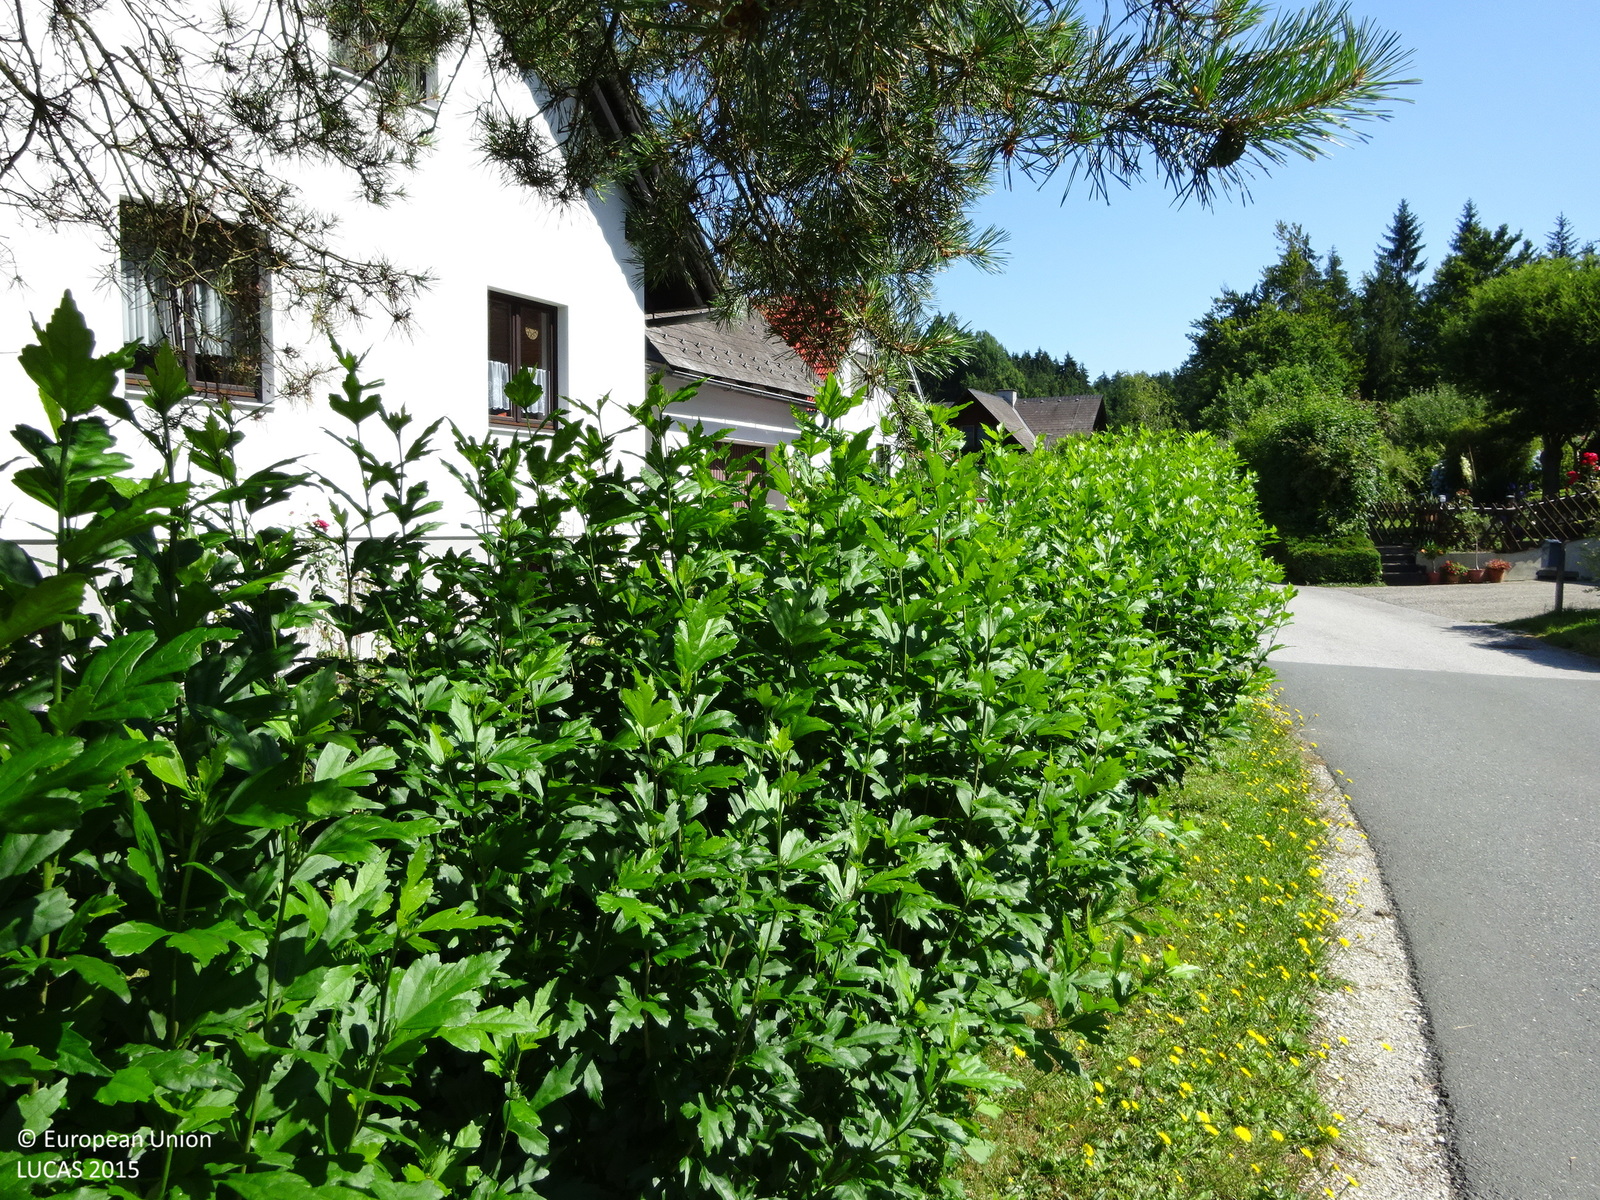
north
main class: Grassland
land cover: Grassland with sparse tree/shrub cover
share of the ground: > 75 %
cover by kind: herbaceous plants 90 %, coniferous forest trees 5 %, shrubs 5 %
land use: Residential
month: July
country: AT
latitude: 46.9074
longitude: 15.2637
